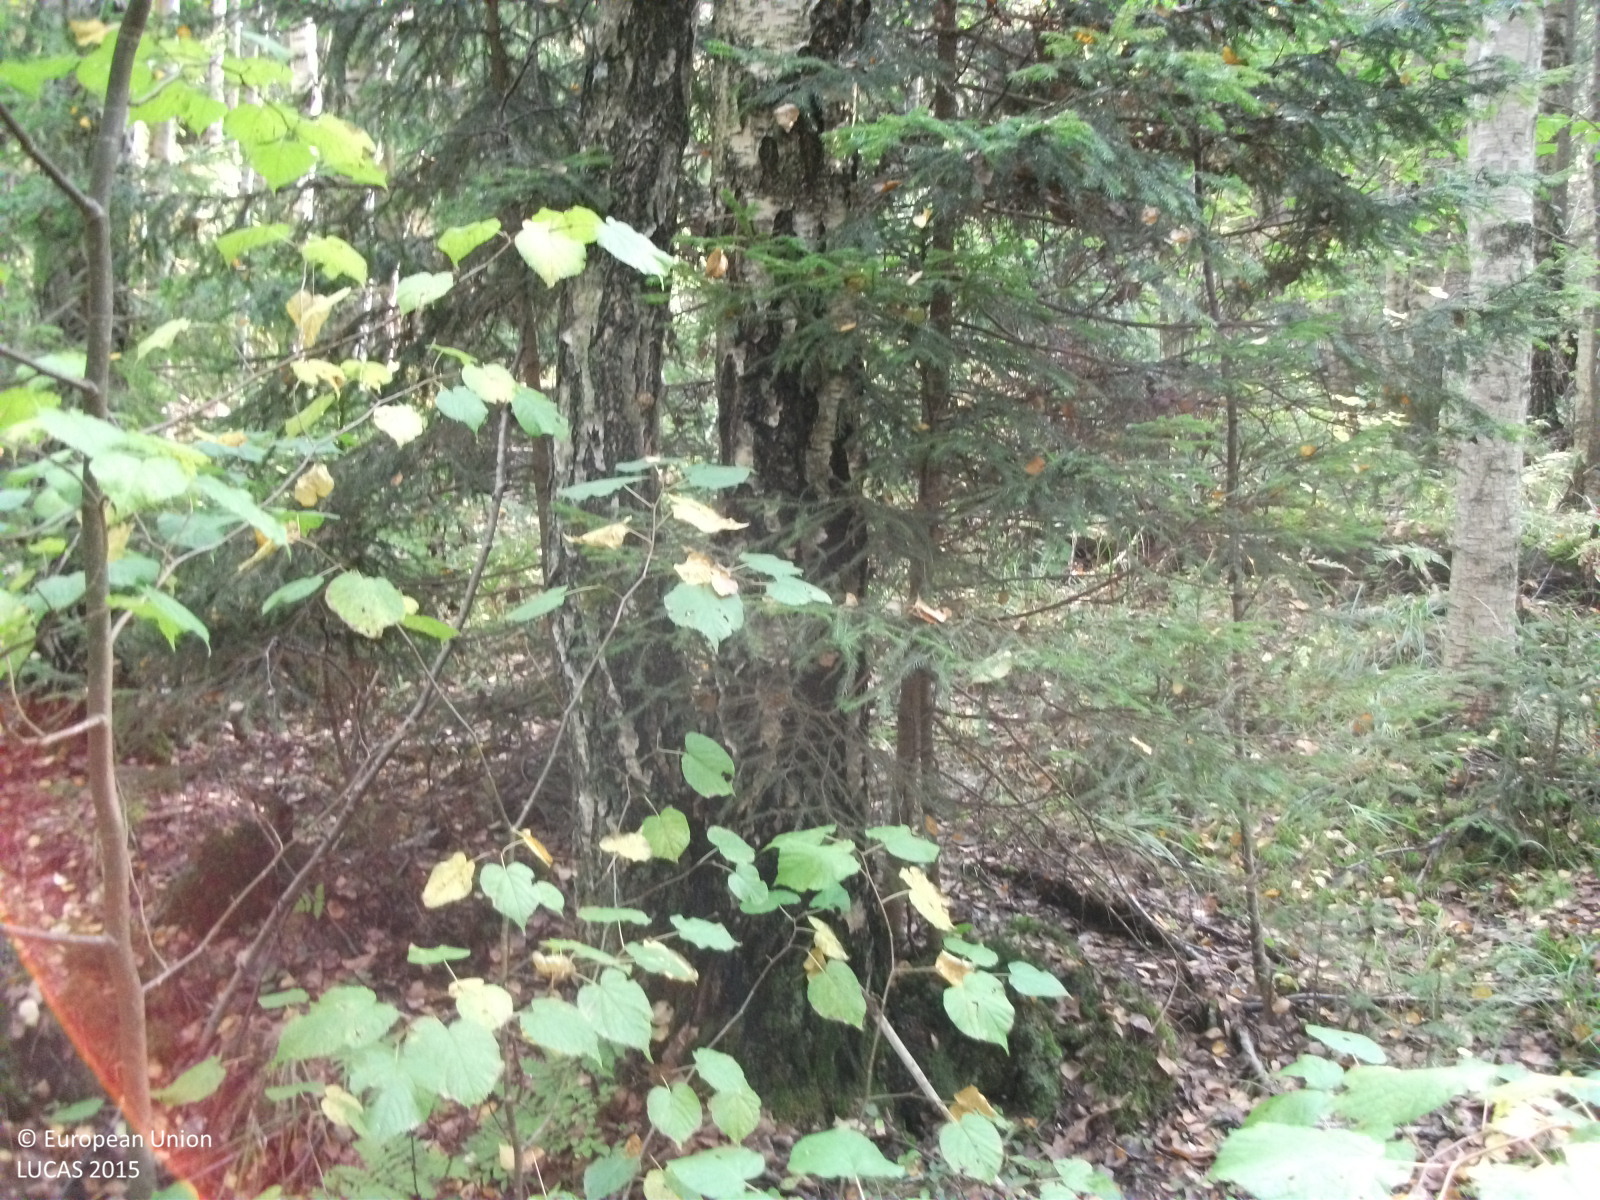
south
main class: Woodland
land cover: Spruce dominated mixed woodland
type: hemiboreal forest and nemoral coniferous forest and mixed broadleaved-coniferous forest
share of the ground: > 75 %
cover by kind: coniferous forest trees 50 %, broadleaved forest trees 30 %, herbaceous plants 10 %, shrubs 5 %, unconsolidated bare surface 5 %
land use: Forestry
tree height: > 5 m
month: September
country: LV
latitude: 57.8105
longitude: 24.5132
